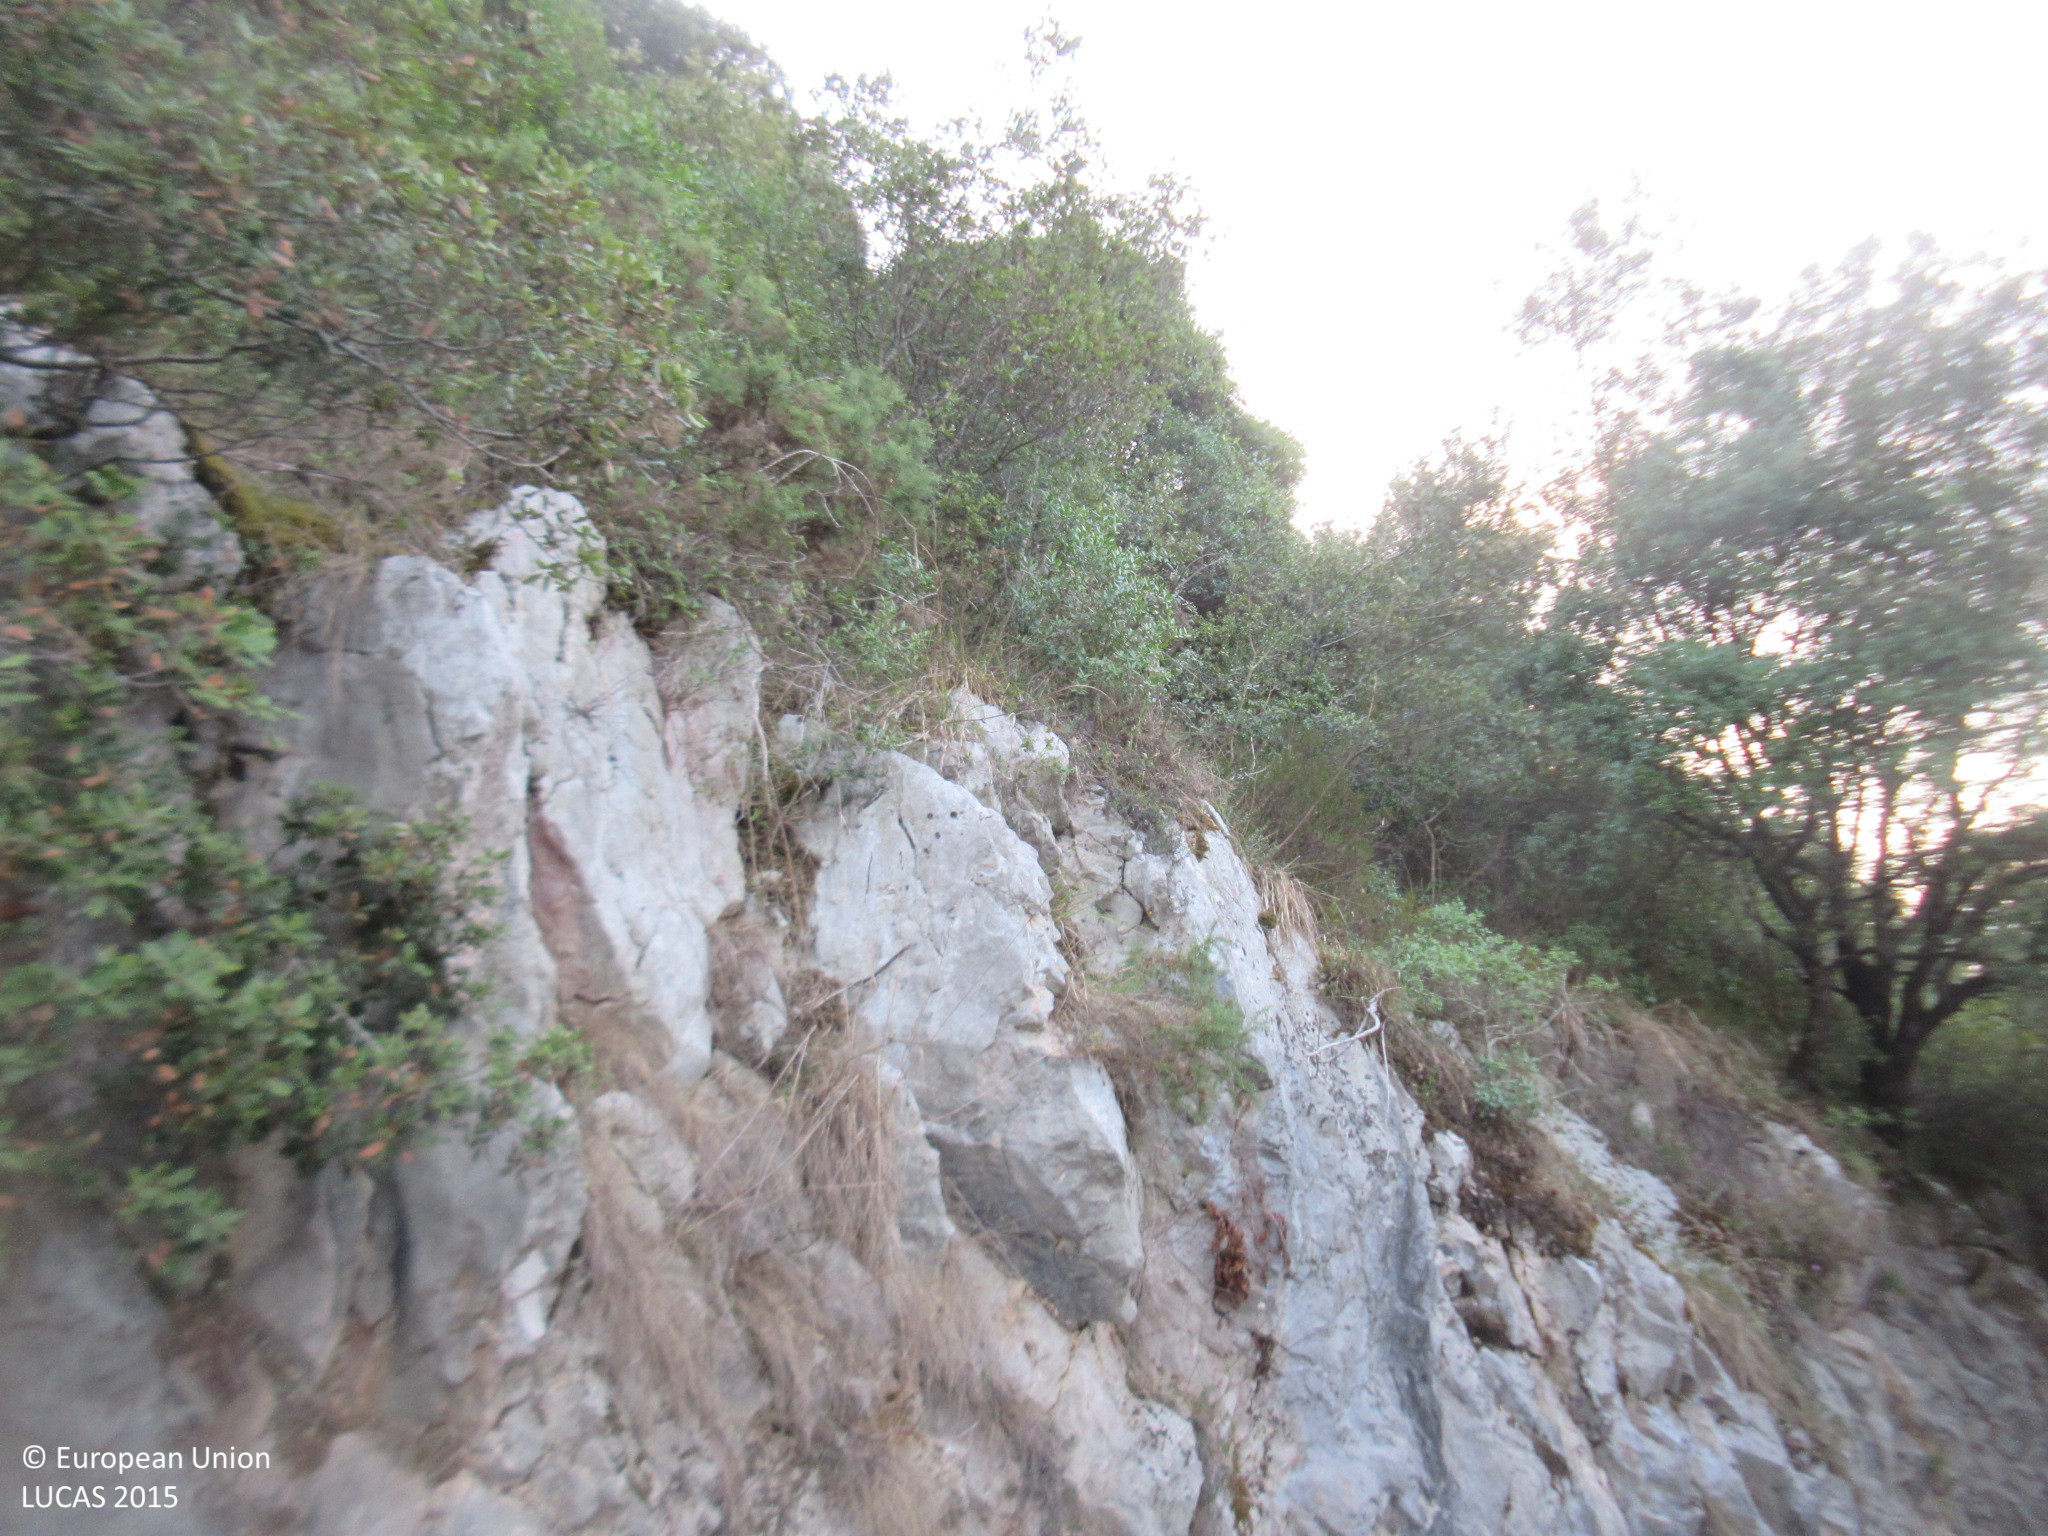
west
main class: Woodland
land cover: Broadleaved woodland
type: broadleaved evergreen forest
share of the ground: 50 - 75 %
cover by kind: broadleaved forest trees 70 %, shrubs 30 %
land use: Semi-natural and natural areas not in use
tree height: > 5 m
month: July
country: ES
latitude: 43.2911
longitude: -3.9652
